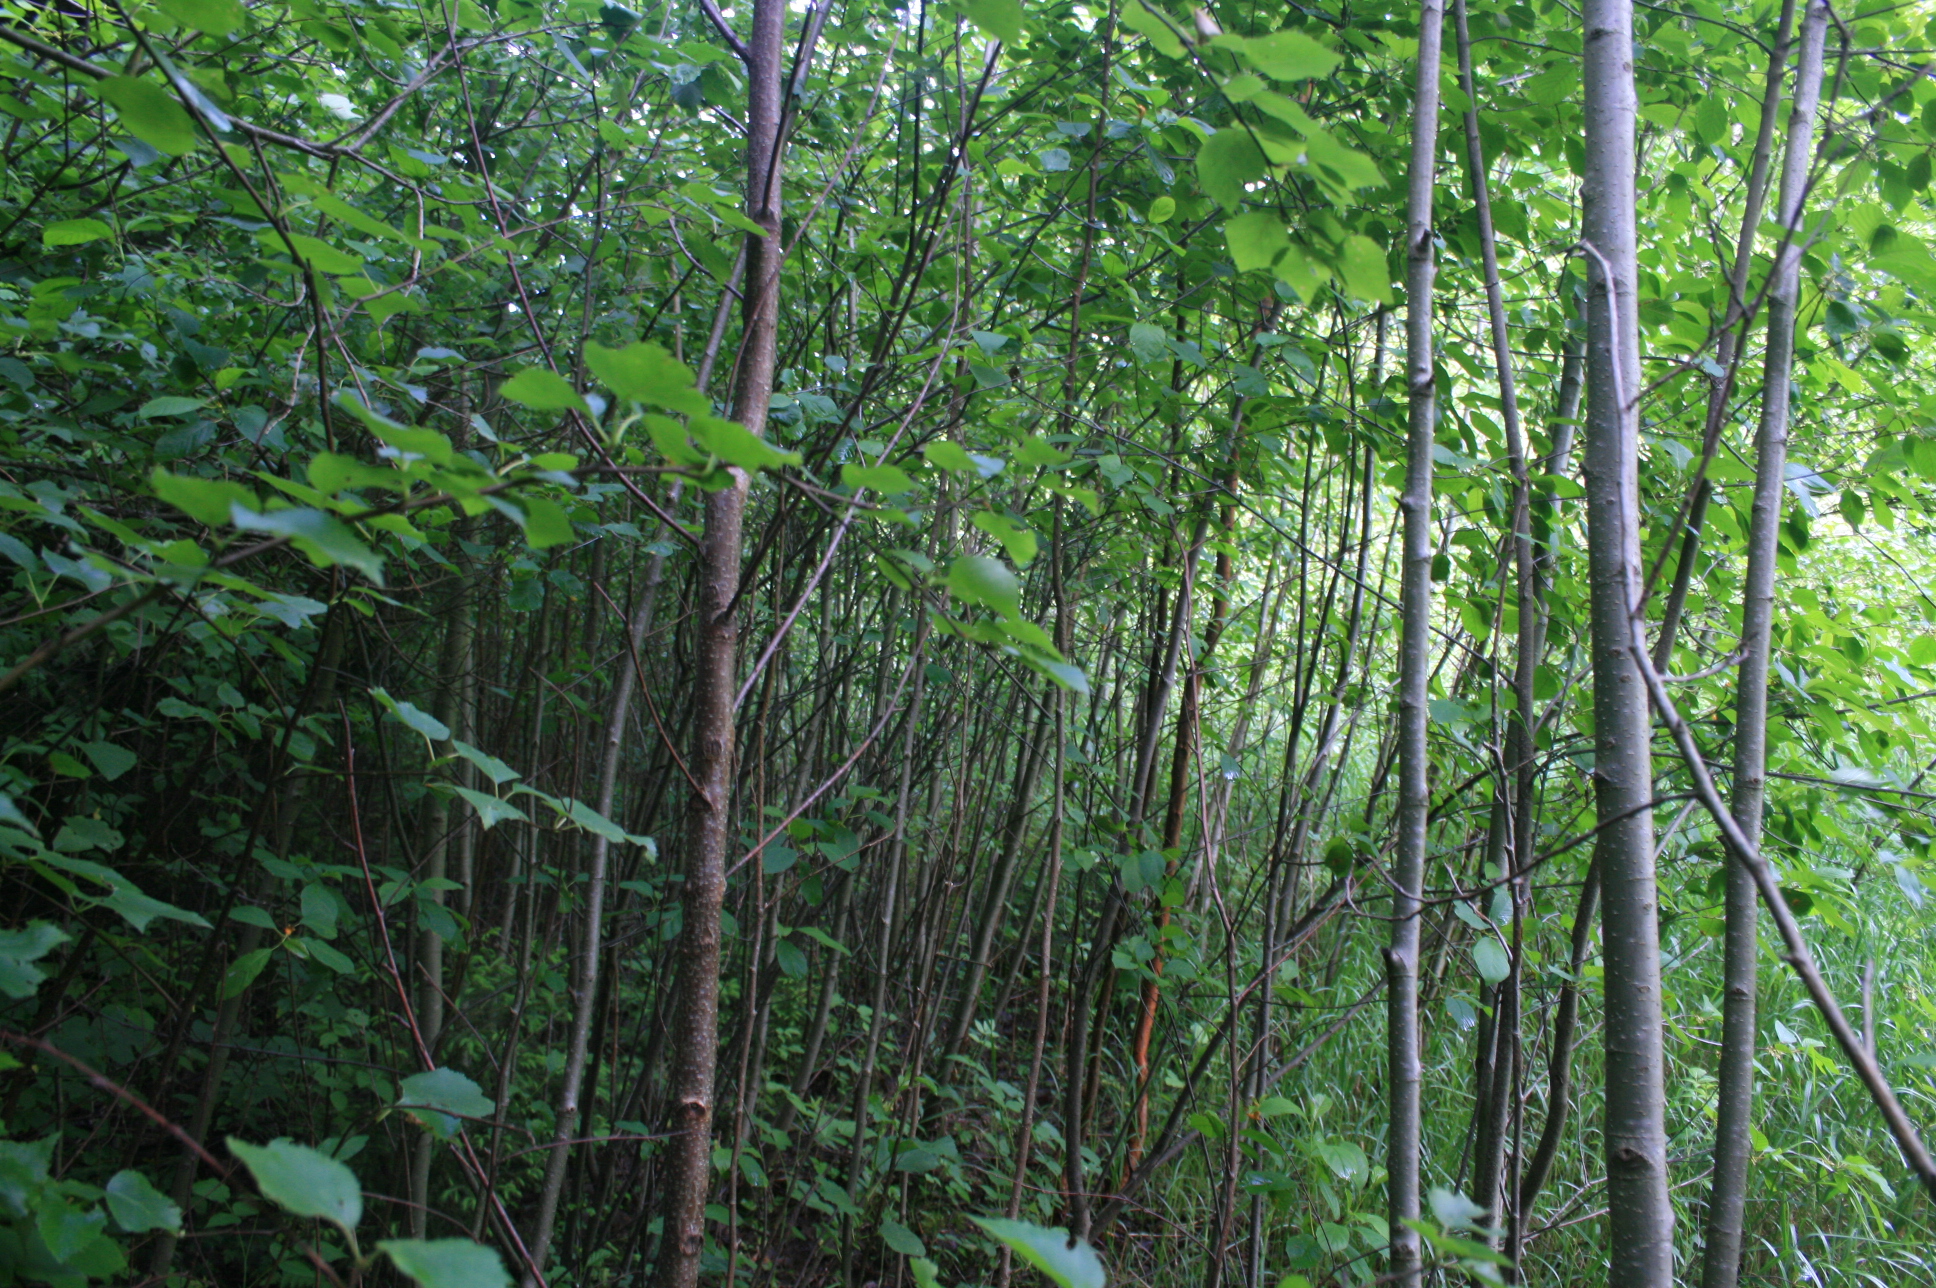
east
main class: Woodland
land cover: Spruce dominated mixed woodland
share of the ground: > 75 %
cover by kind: broadleaved forest trees 70 %, coniferous forest trees 30 %
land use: Forestry
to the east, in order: Spruce dominated mixed woodland; Broadleaved woodland; Electric lines; Broadleaved woodland; Spruce dominated mixed woodland; Broadleaved woodland; Artificial constructions in urban areas; Grassland without tree/shrub cover
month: June
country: LT
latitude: 55.4794
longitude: 22.1598
